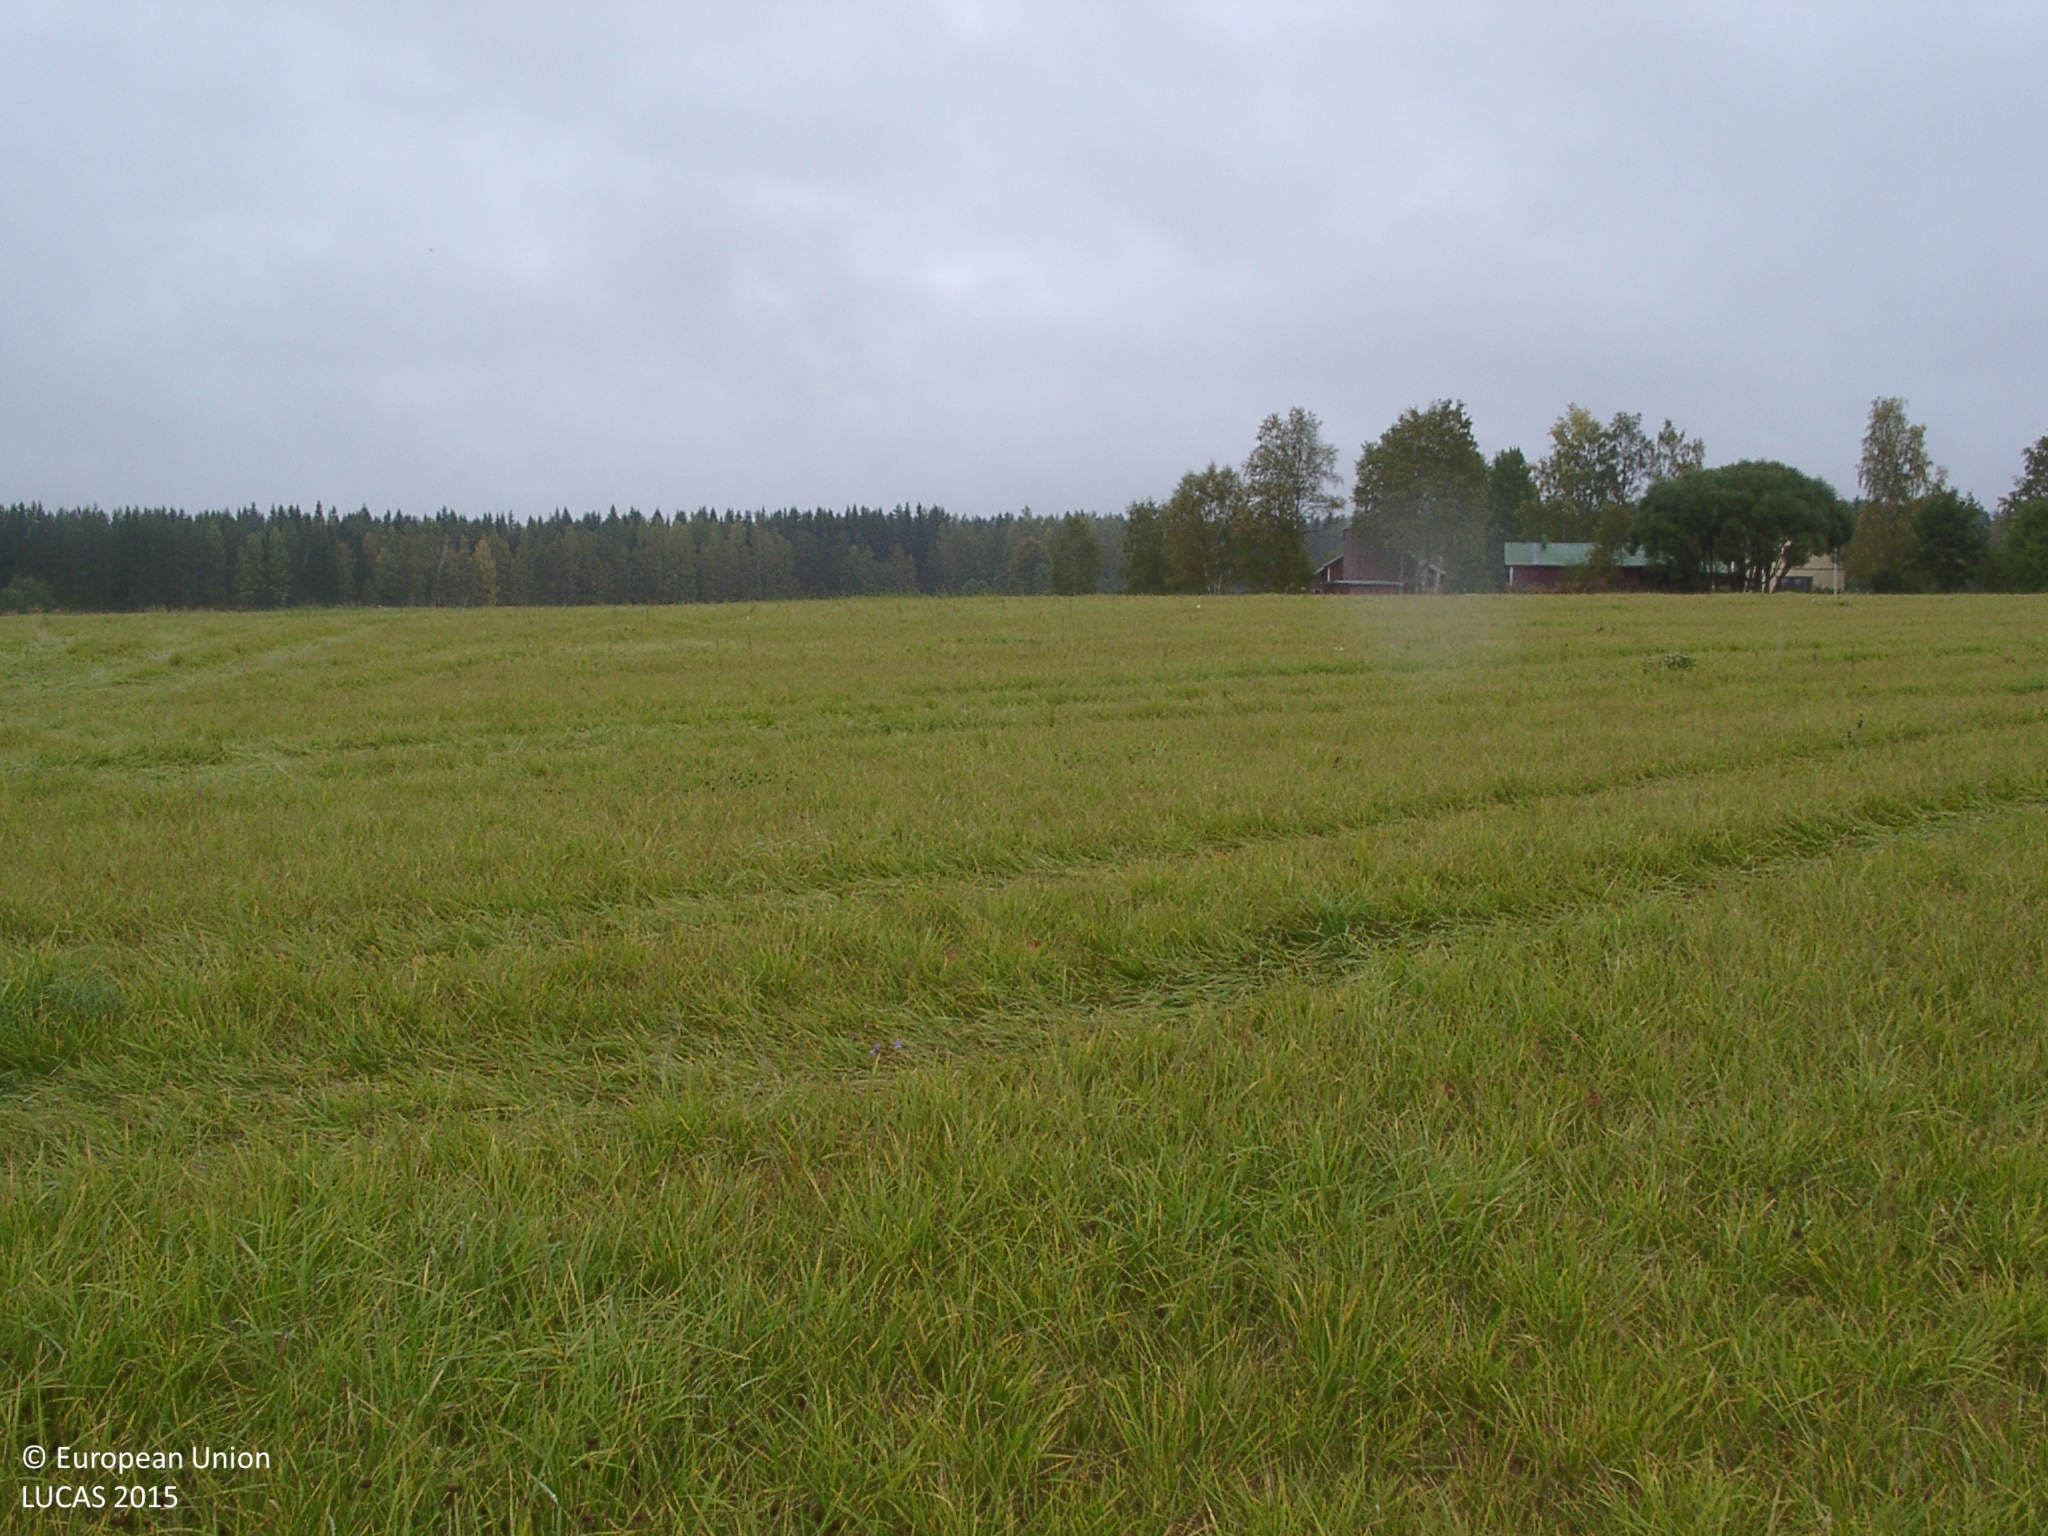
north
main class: Cropland
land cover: Temporary grasslands
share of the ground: > 75 %
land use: Agriculture (excluding fallow land and kitchen gardens)
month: September
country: FI
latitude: 62.5646
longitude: 25.6194
